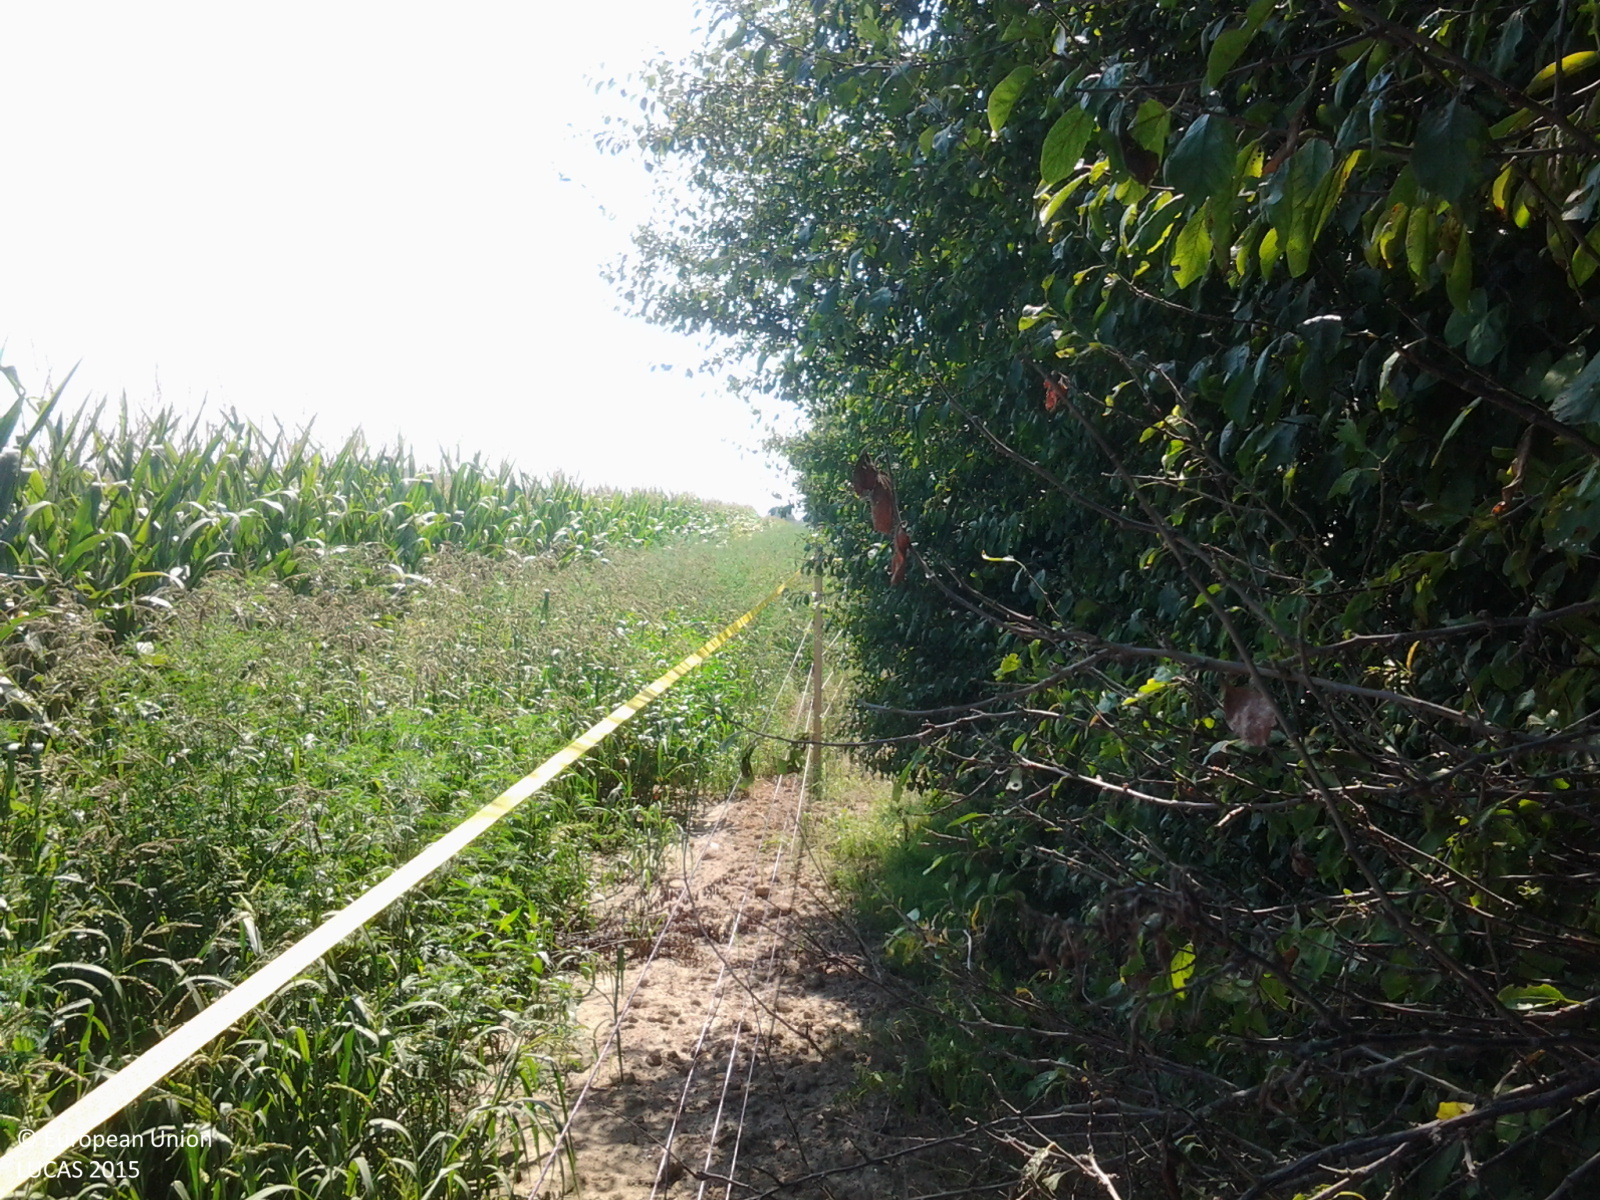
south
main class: Shrubland
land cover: Shrubland without tree cover
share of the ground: > 75 %
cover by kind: shrubs 90 %, herbaceous plants 10 %
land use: Abandoned areas
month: August
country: HU
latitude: 46.5568
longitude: 16.9814
